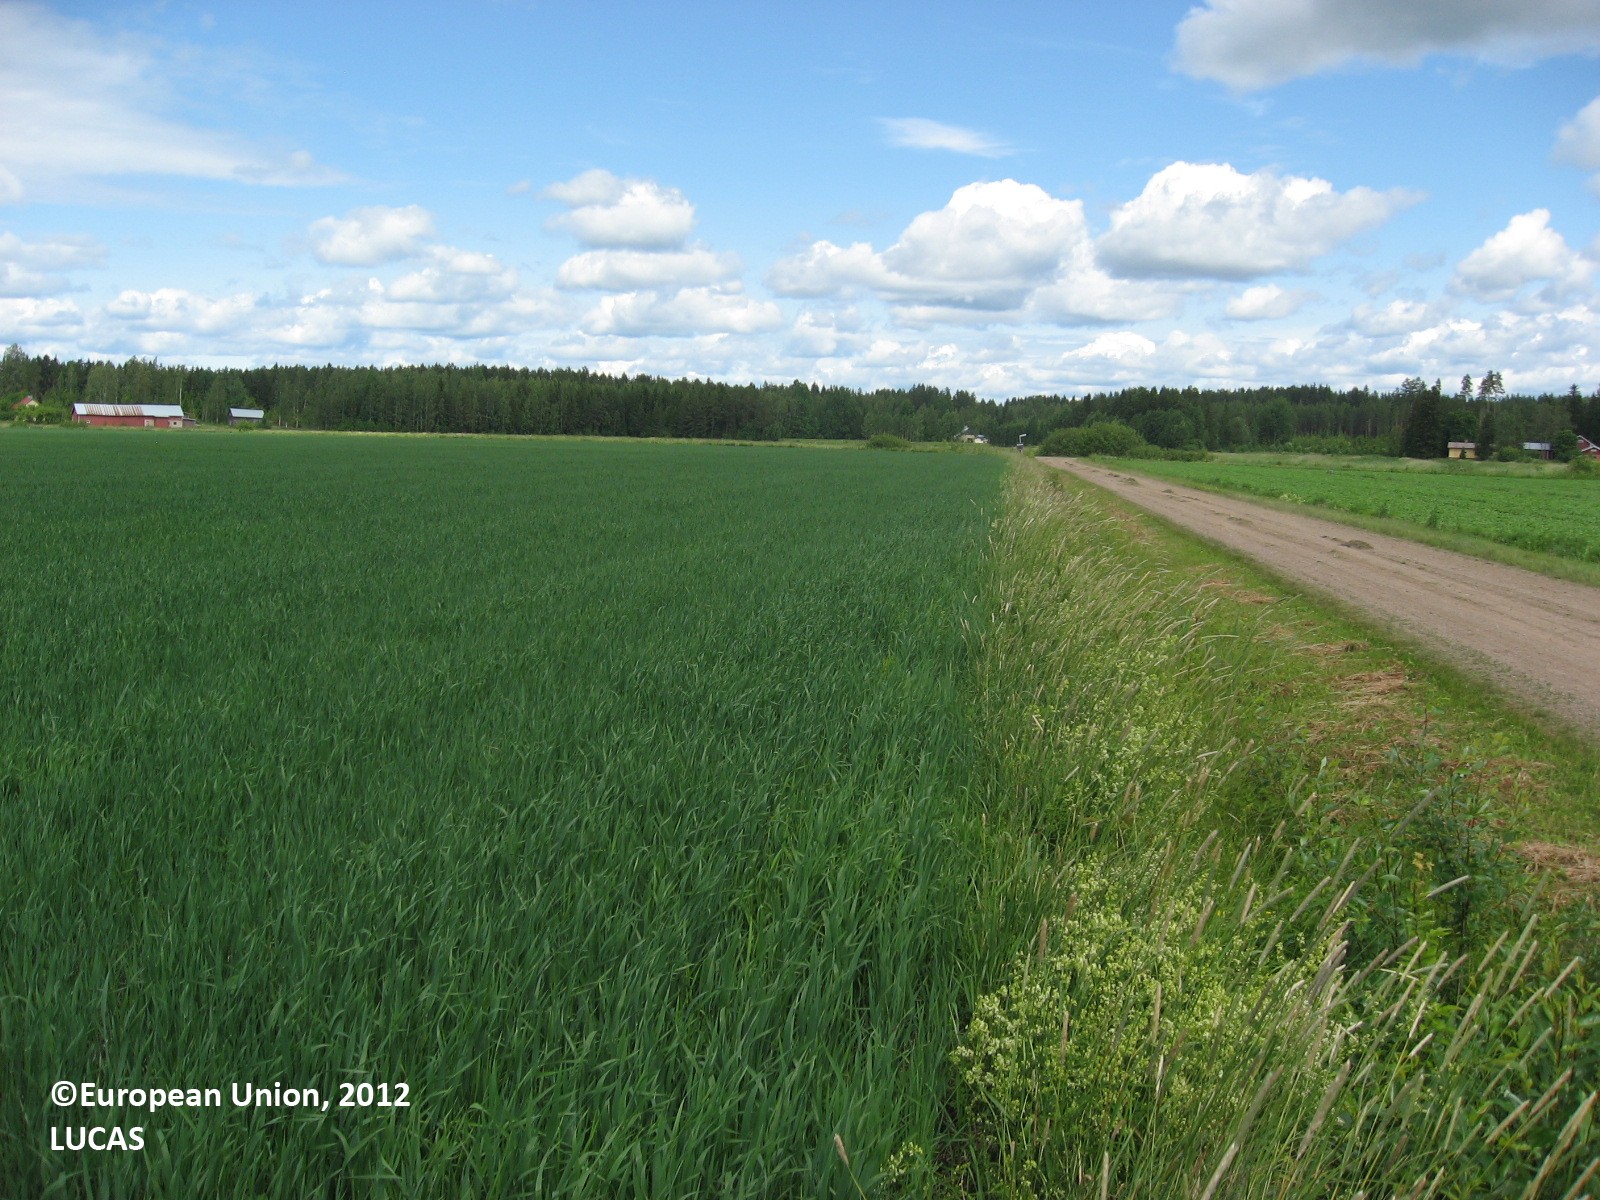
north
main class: Cropland
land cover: Oats
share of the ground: > 75 %
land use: Agriculture (excluding fallow land and kitchen gardens)
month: June
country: FI
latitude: 60.7623
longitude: 26.5452
